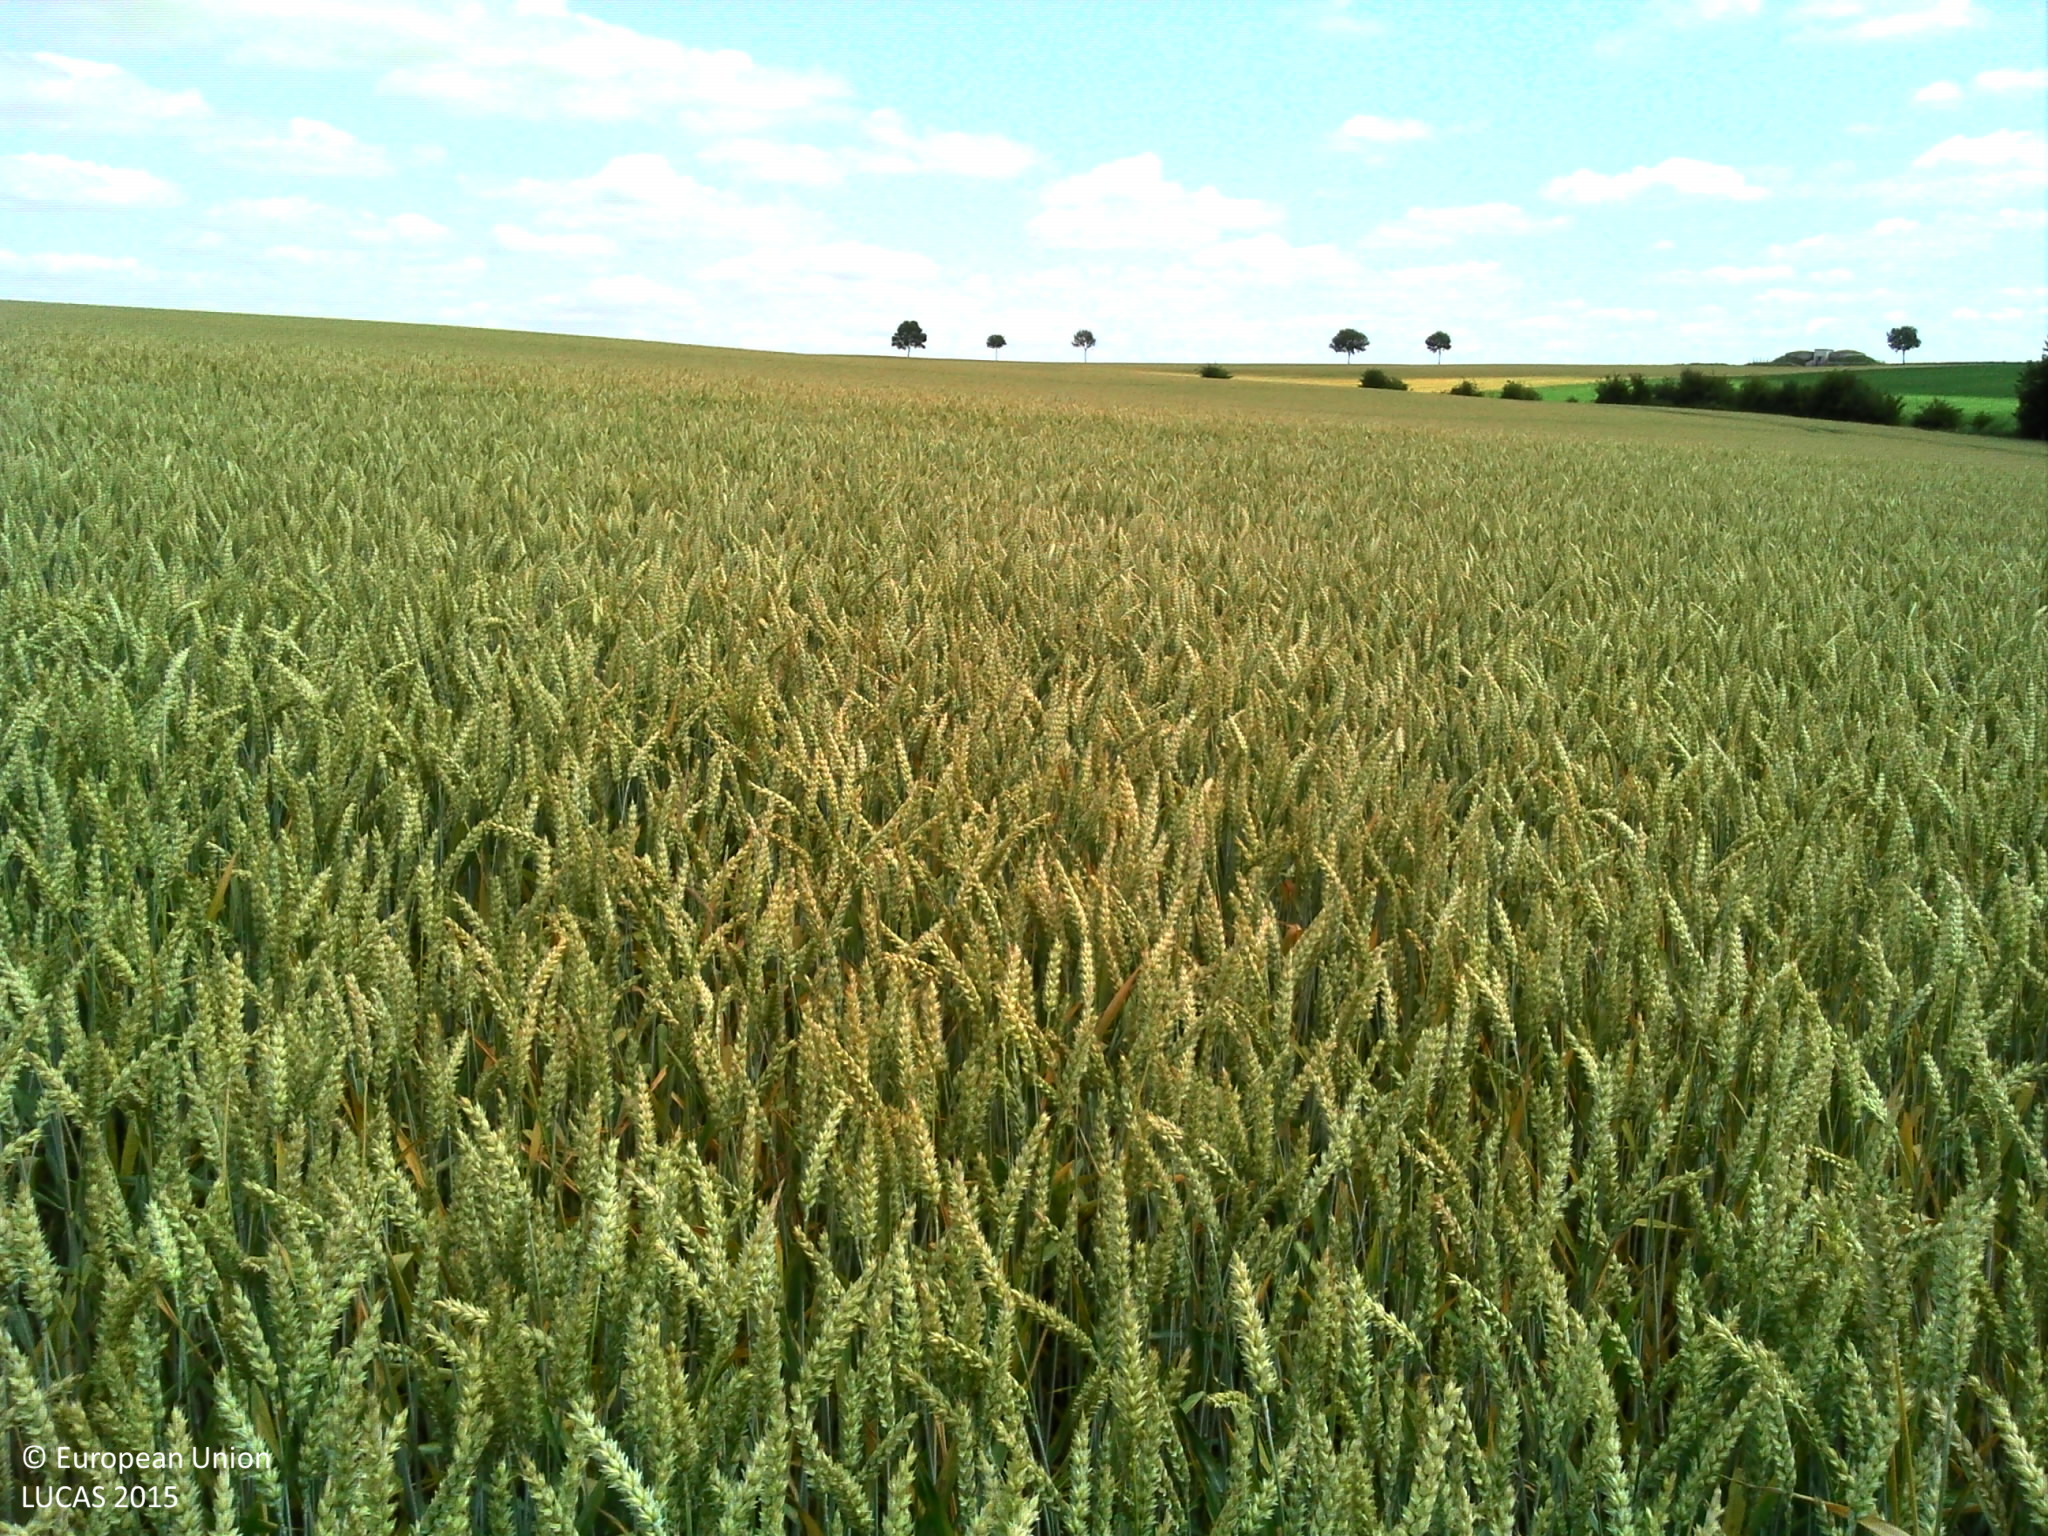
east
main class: Cropland
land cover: Common wheat
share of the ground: > 75 %
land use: Agriculture (excluding fallow land and kitchen gardens)
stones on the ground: 10 - 25 %
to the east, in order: Common wheat
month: July
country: FR
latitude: 50.3297
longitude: 2.1608
